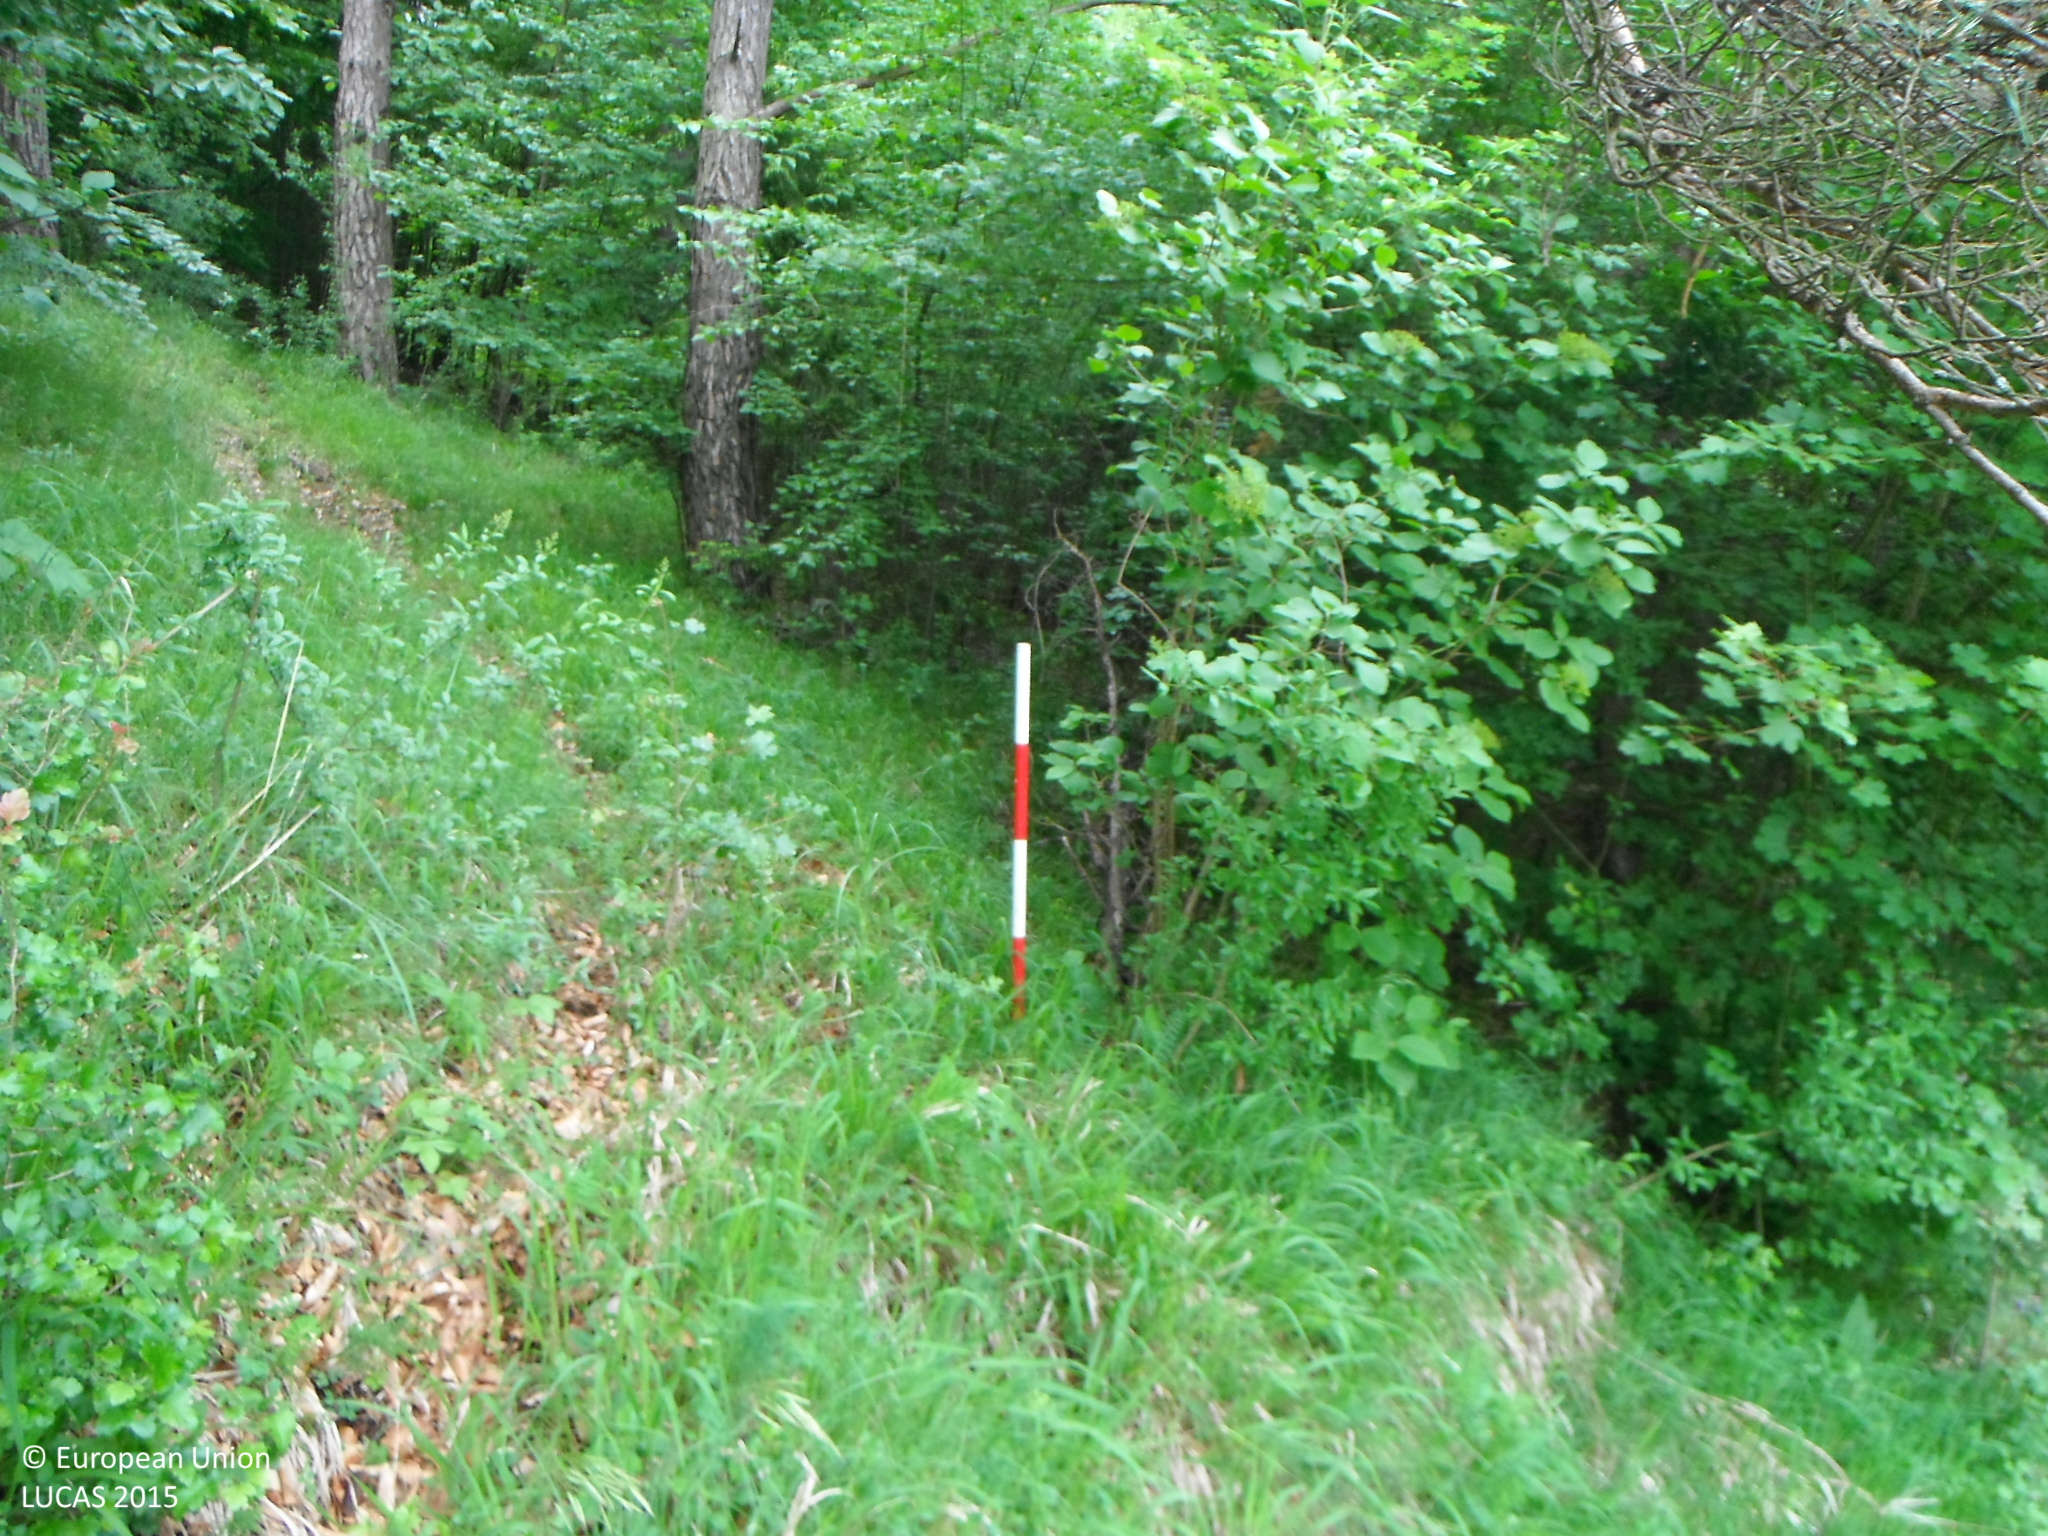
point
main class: Woodland
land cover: Pine dominated mixed woodland
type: hemiboreal forest and nemoral coniferous forest and mixed broadleaved-coniferous forest
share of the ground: > 75 %
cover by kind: coniferous forest trees 75 %, broadleaved forest trees 25 %
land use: Forestry
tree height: > 5 m
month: May
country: SK
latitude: 48.7790
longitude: 19.2087
